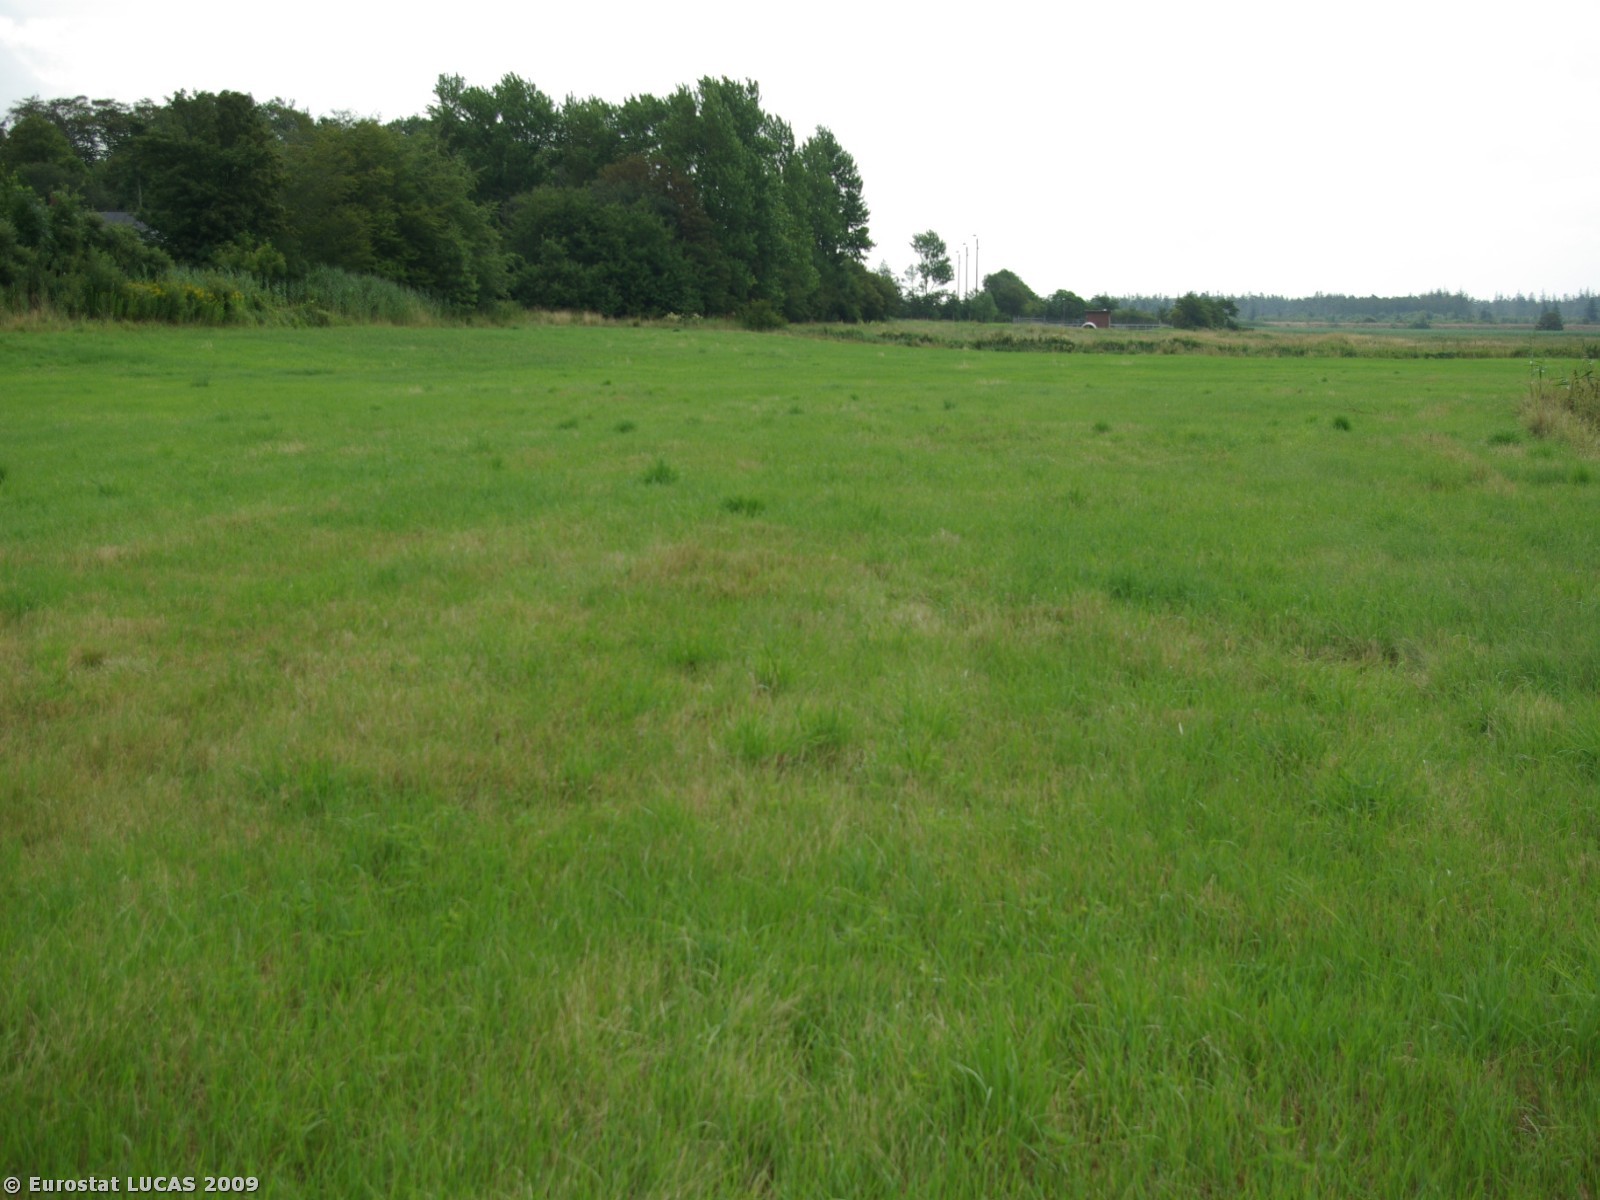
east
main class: Grassland
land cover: Grassland without tree/shrub cover
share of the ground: > 75 %
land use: Agriculture (excluding fallow land and kitchen gardens)
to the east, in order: Grassland without tree/shrub cover; Grass margins; Ditches and canals; Grass margins; Fences; Grassland without tree/shrub cover; Fences; Grass margins; Ditches and canals; Broadleaved woodland; Grassland with sparse tree/shrub cover; Grassland without tree/shrub cover; Other fresh vegetables; Grassland without tree/shrub cover
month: July
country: DK
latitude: 55.1927
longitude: 8.7286
